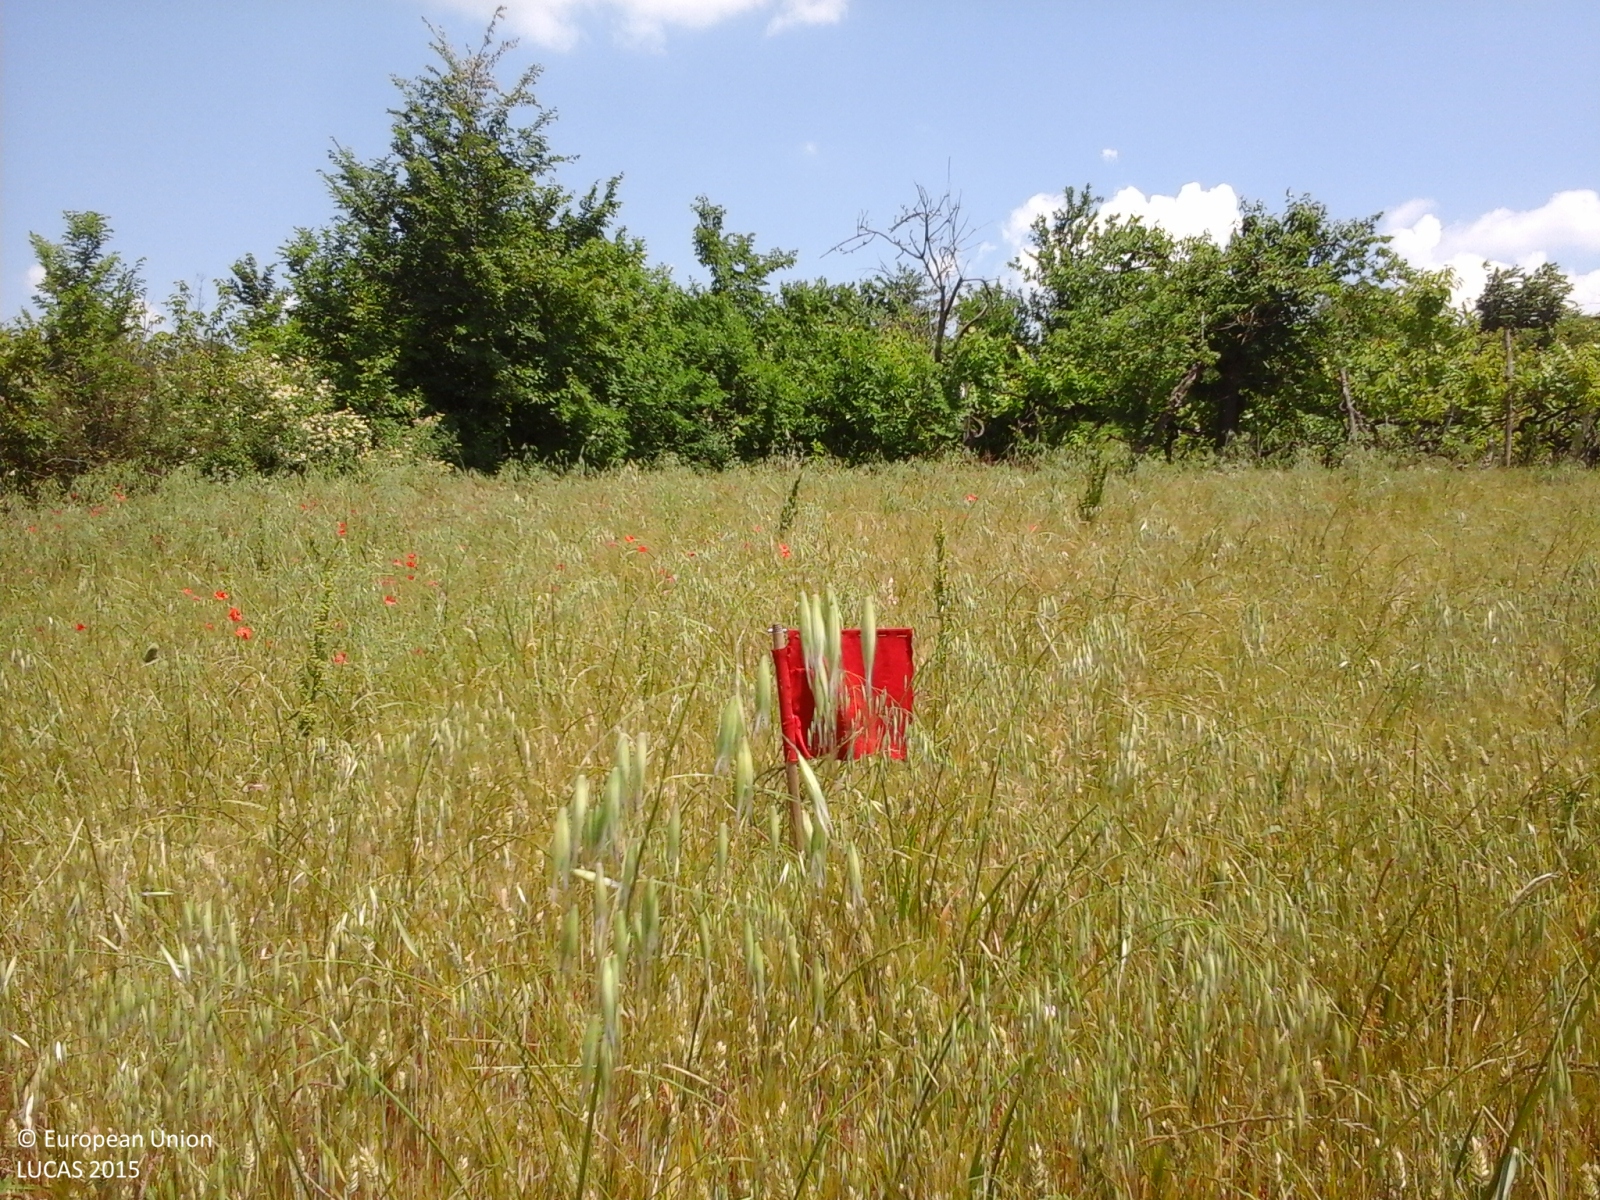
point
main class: Cropland
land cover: Mixed cereals for fodder
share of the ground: > 75 %
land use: Agriculture (excluding fallow land and kitchen gardens)
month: June
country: IT
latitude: 41.1488
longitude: 15.1167
